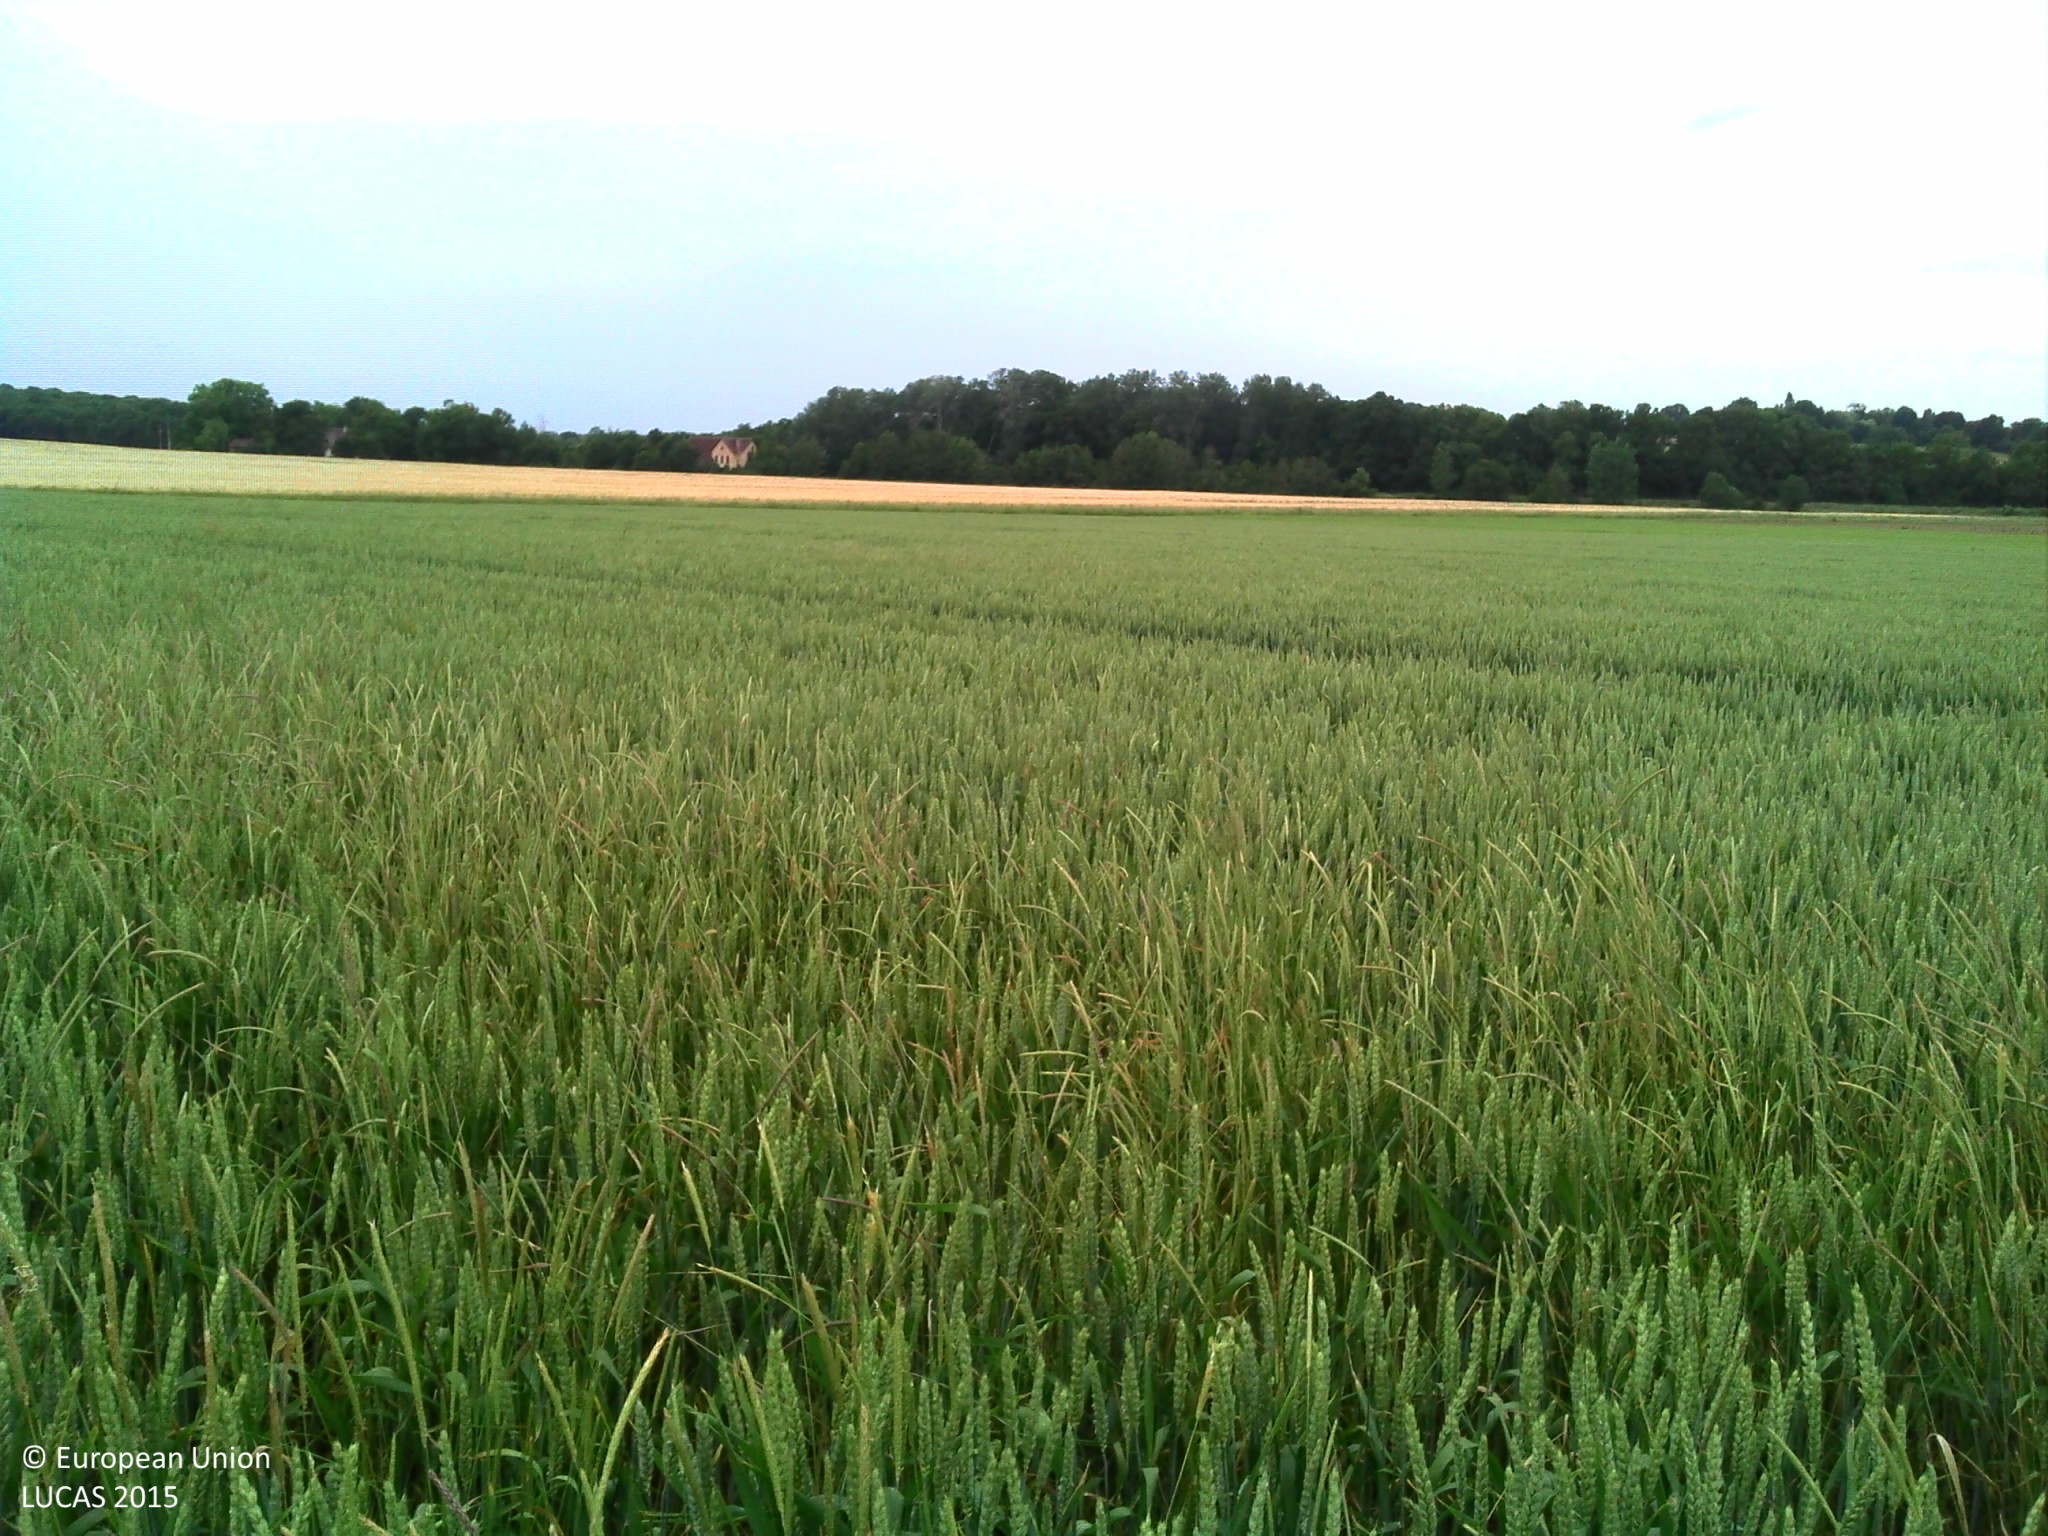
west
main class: Cropland
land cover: Common wheat
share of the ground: > 75 %
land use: Agriculture (excluding fallow land and kitchen gardens)
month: June
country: FR
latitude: 46.7885
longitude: 2.6985
